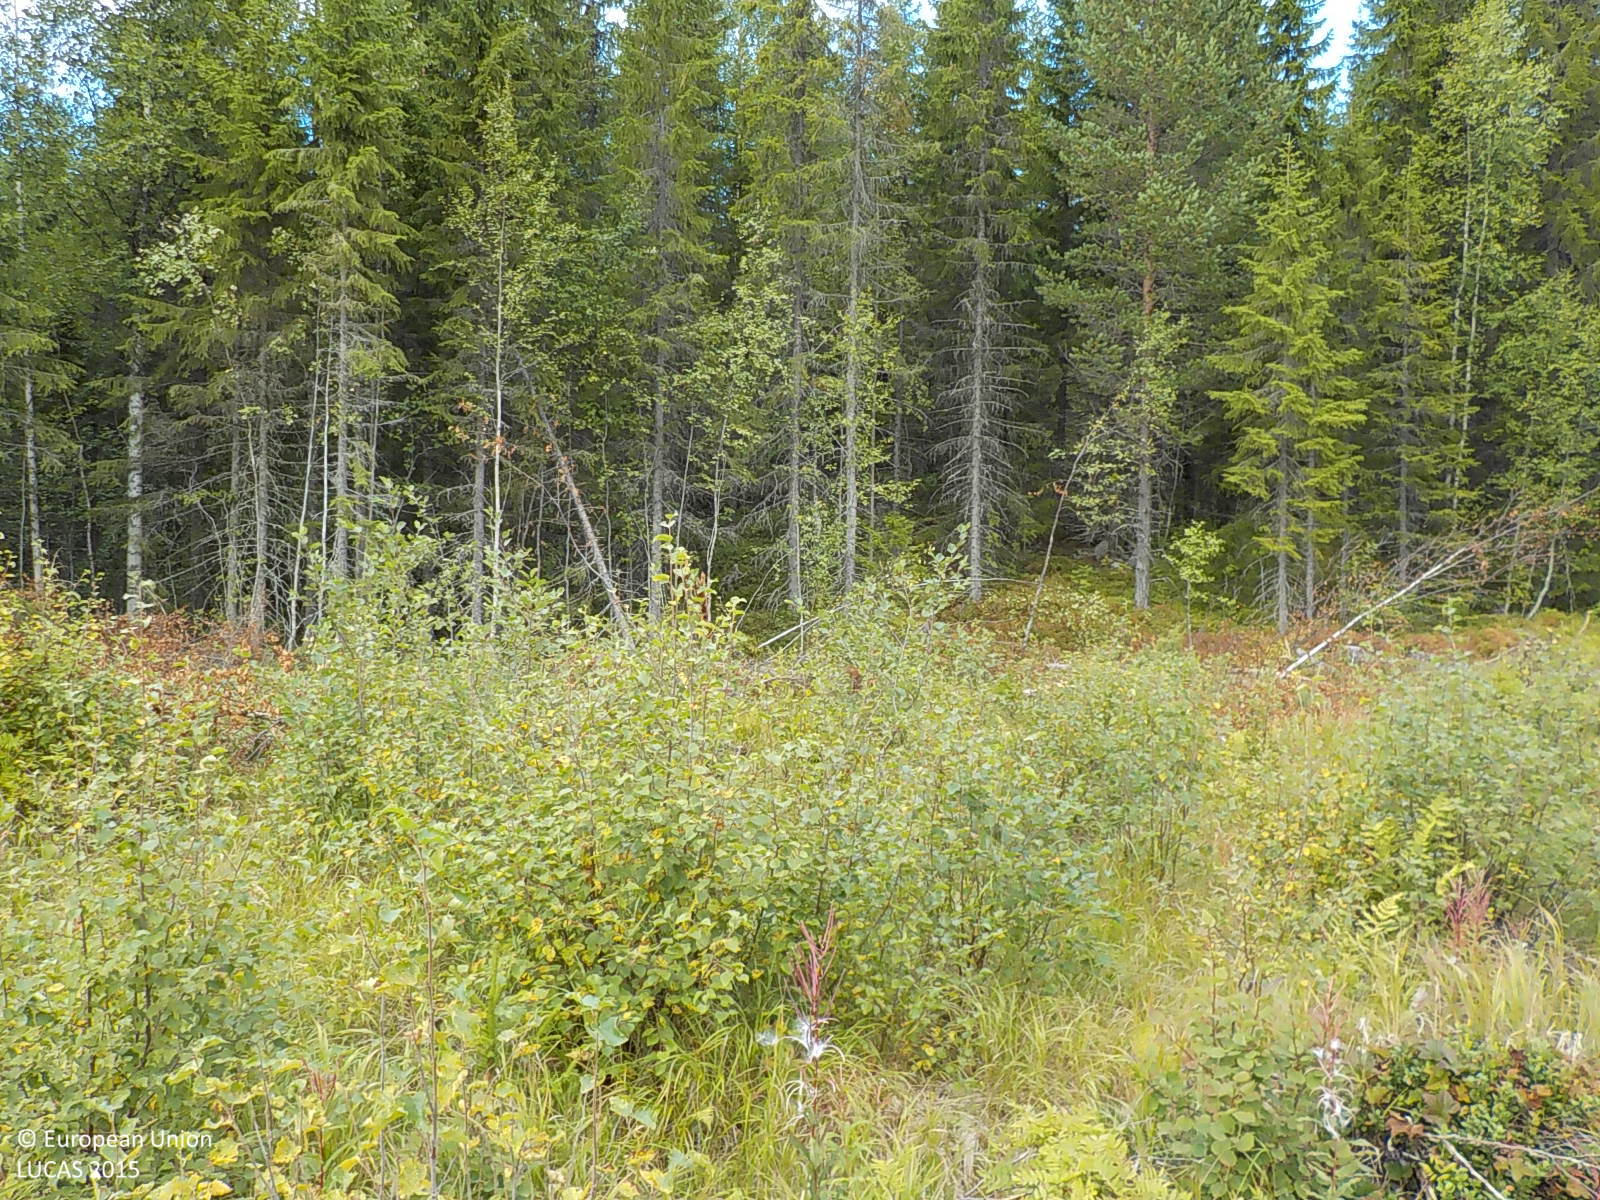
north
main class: Artificial land
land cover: Other artificial areas
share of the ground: 50 - 75 %
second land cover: Broadleaved woodland
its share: 25 - 50 %
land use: Electricity, gas and thermal power distribution
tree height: < 5 m
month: September
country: SE
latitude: 63.2841
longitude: 17.7314
